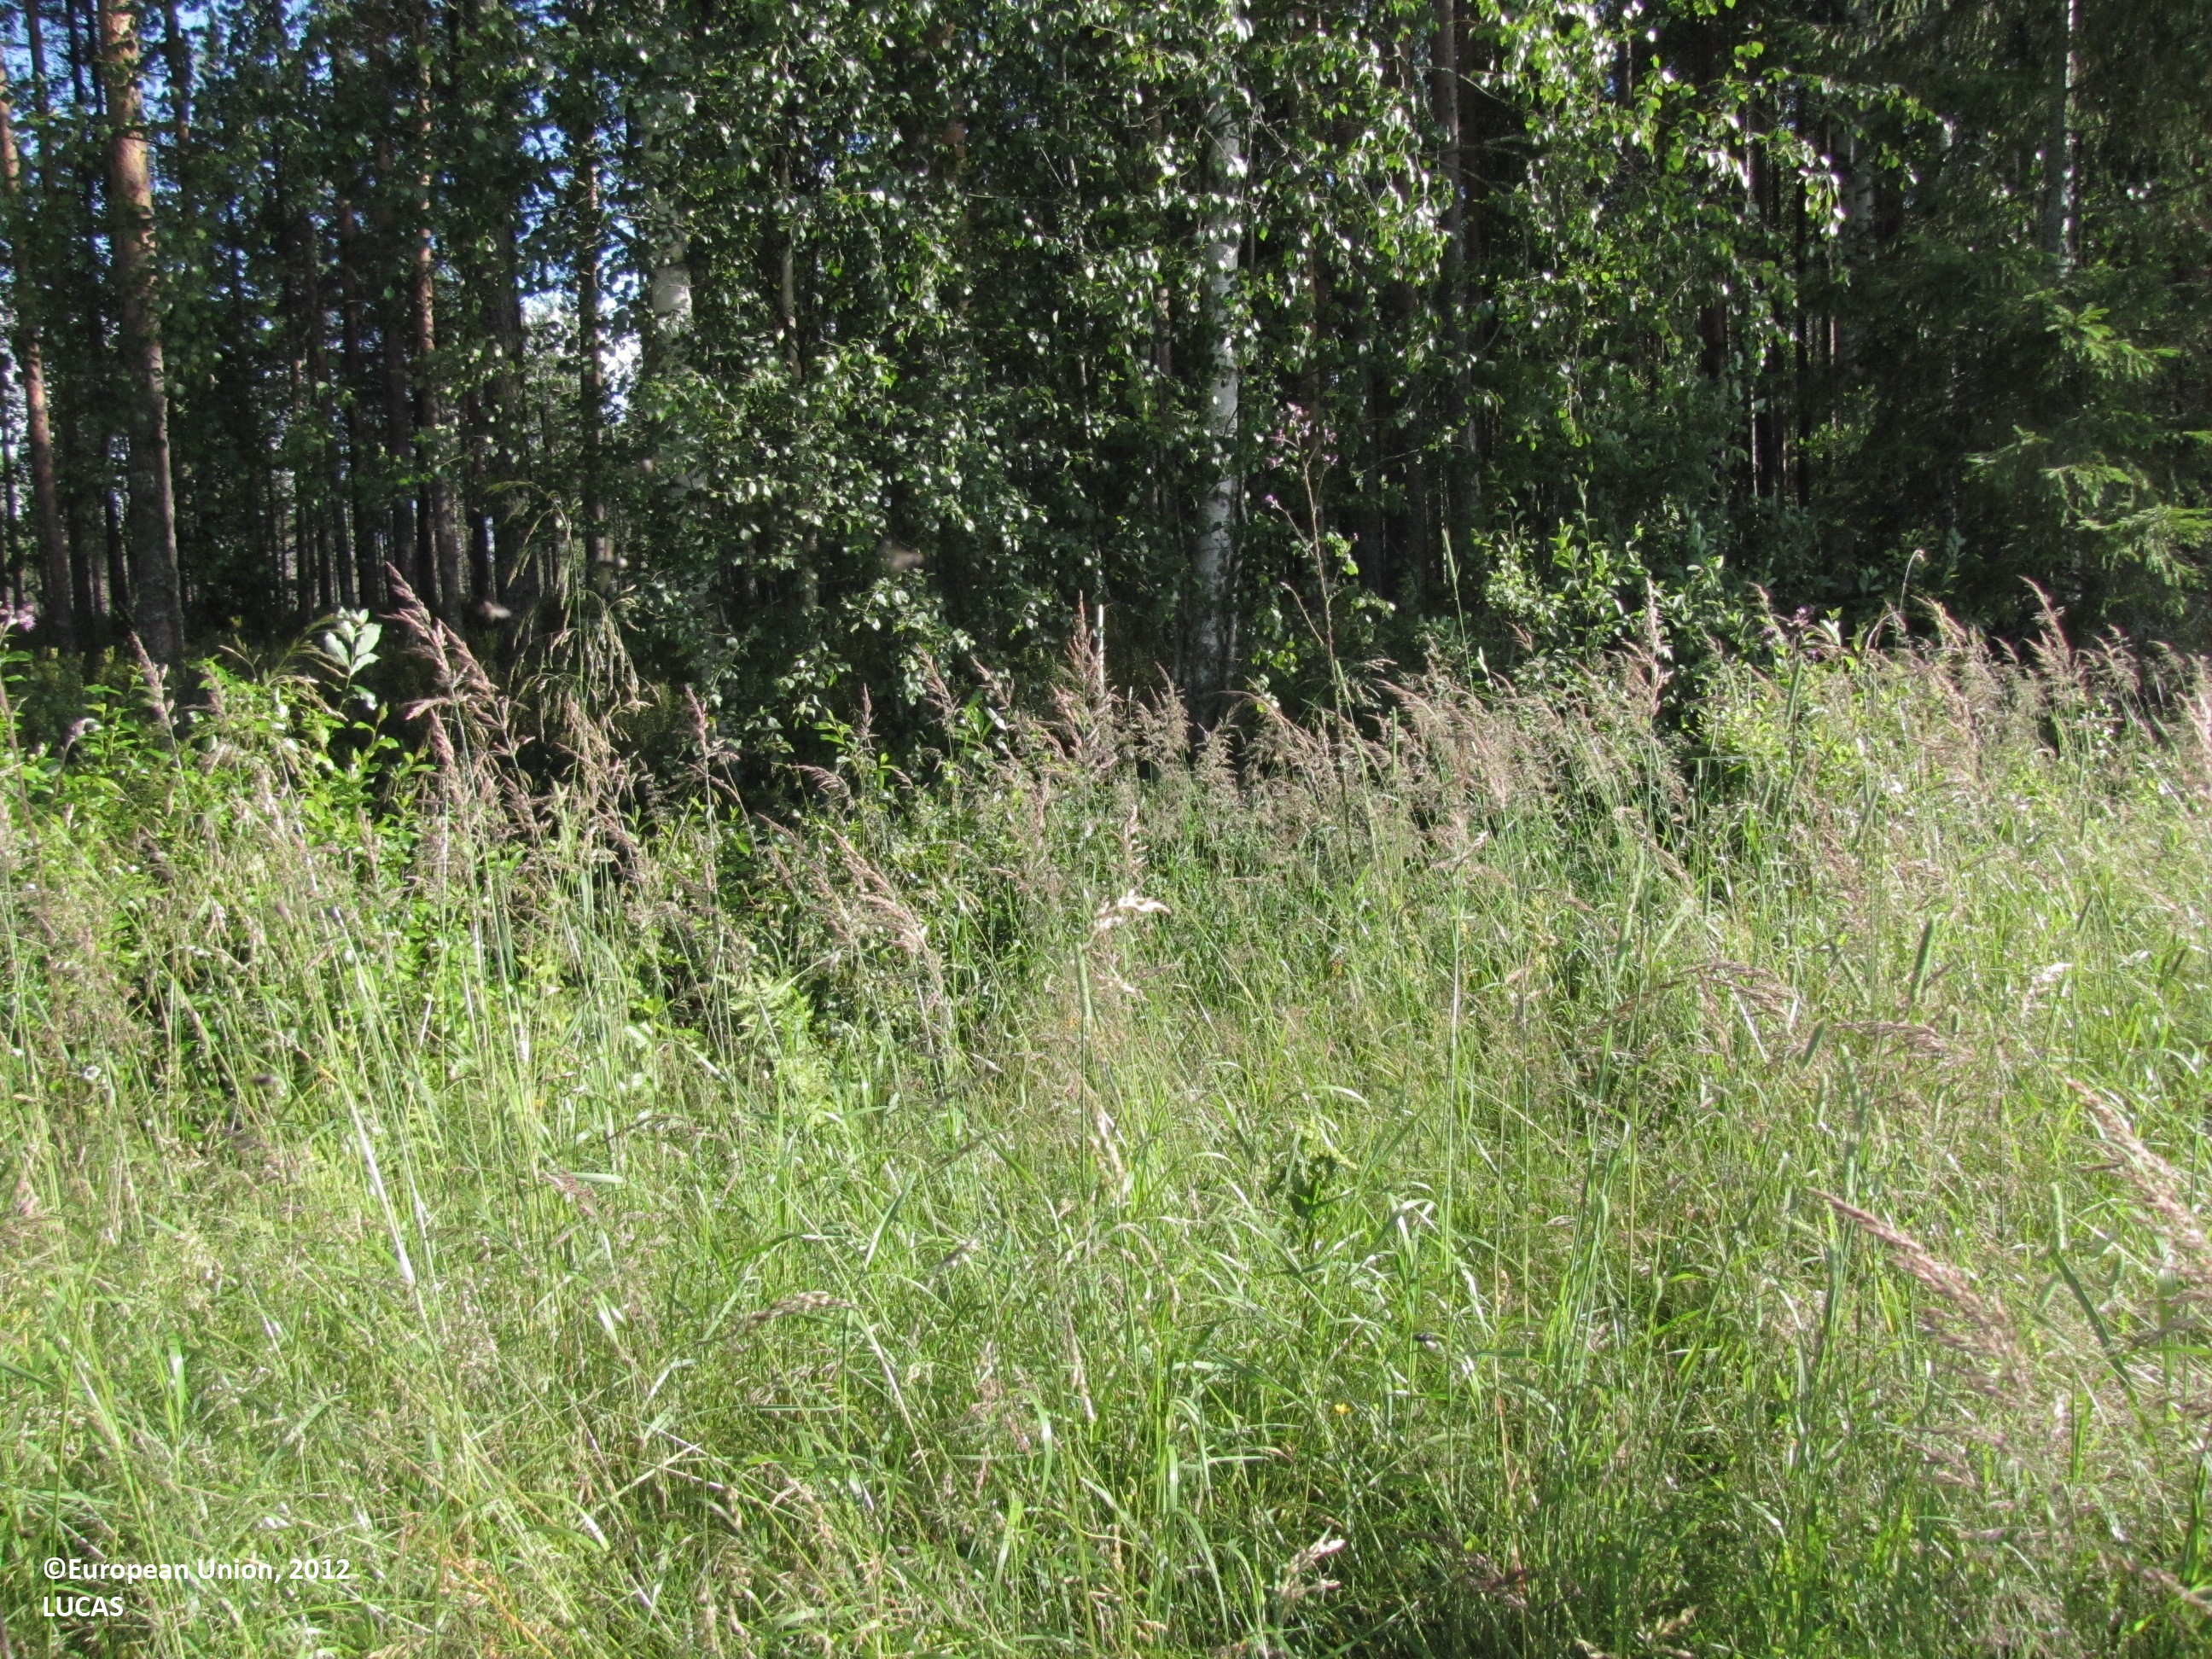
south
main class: Grassland
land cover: Grassland without tree/shrub cover
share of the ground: > 75 %
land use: Fallow land
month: July
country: FI
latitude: 62.5356
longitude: 23.2637
